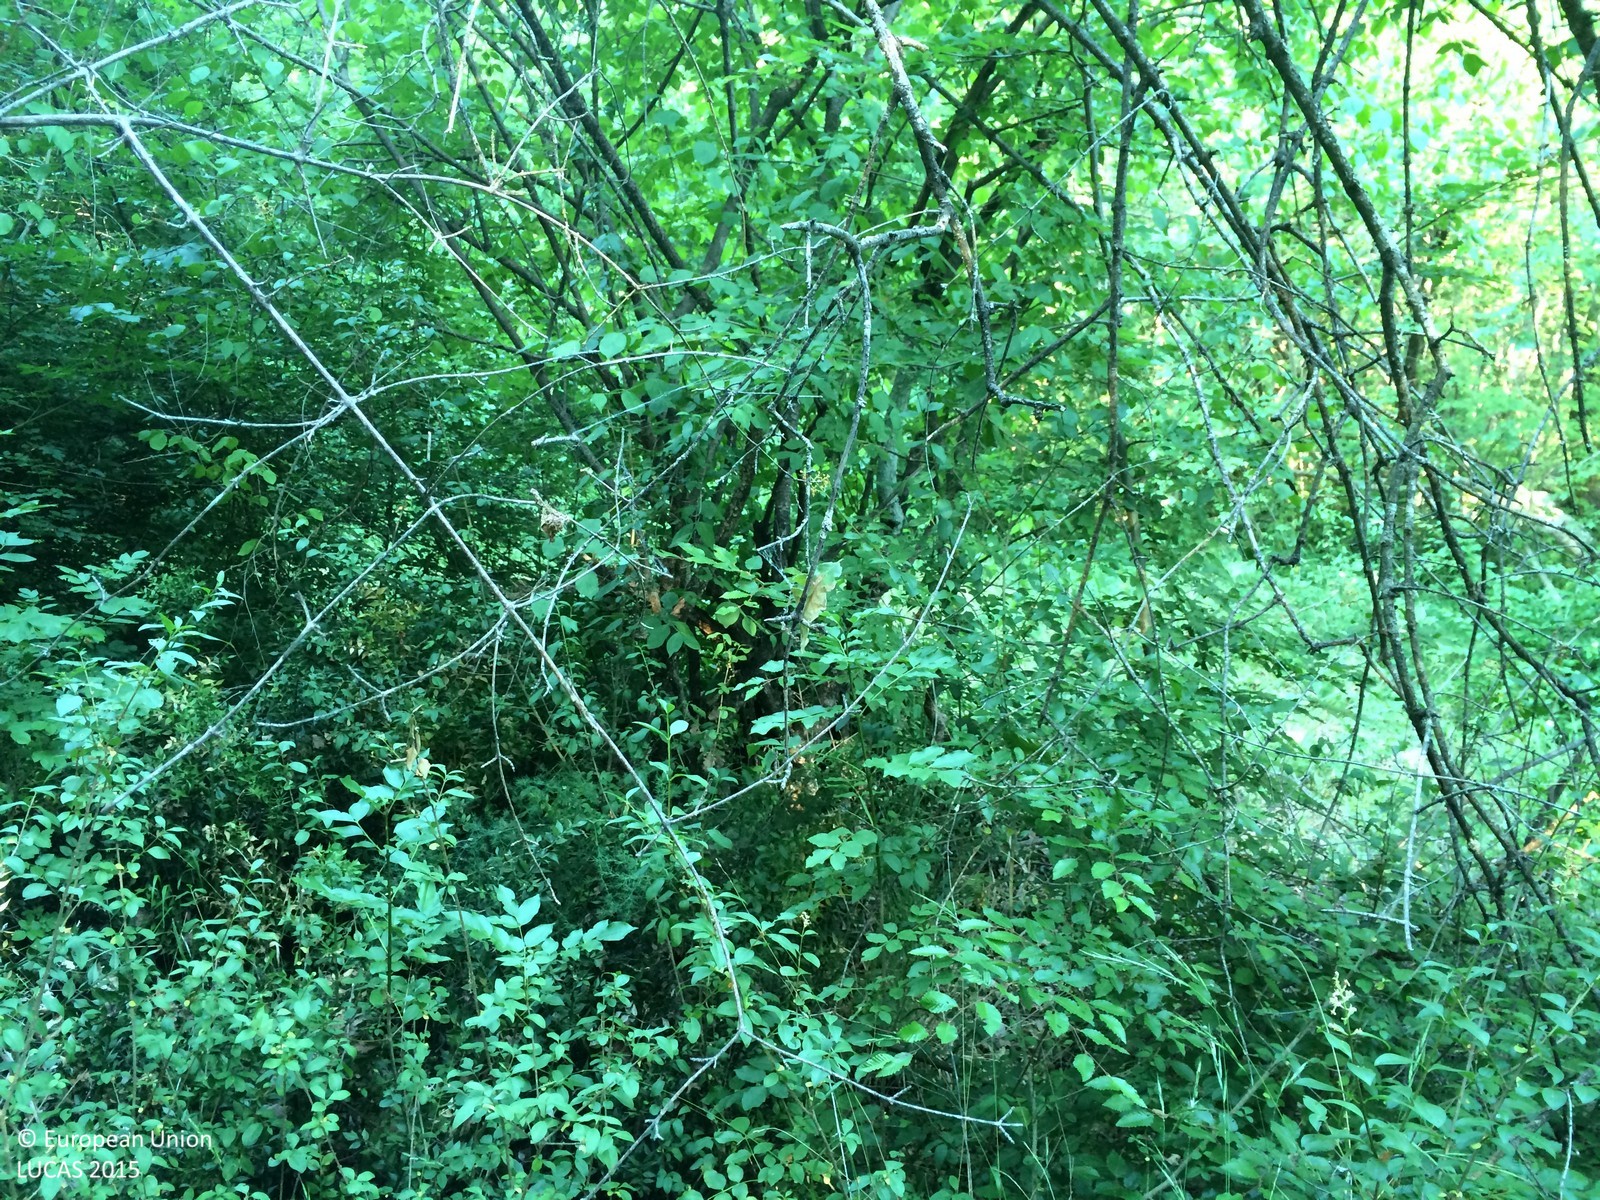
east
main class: Woodland
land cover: Broadleaved woodland
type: mesophytic deciduous forest
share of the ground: > 75 %
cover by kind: broadleaved forest trees 90 %, shrubs 10 %
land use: Semi-natural and natural areas not in use
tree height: > 5 m
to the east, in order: Broadleaved woodland; Tracks; Broadleaved woodland; Dry stone walls; Broadleaved woodland; Dry stone walls; Broadleaved woodland; Dry stone walls; Broadleaved woodland; Grassland with sparse tree/shrub cover; Managed hedges; Grassland without tree/shrub cover; Broadleaved woodland; Shruby margins; Fences; Grassland without tree/shrub cover; Paved roads, cycling and walking lanes
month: June
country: HR
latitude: 45.0196
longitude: 13.8395
